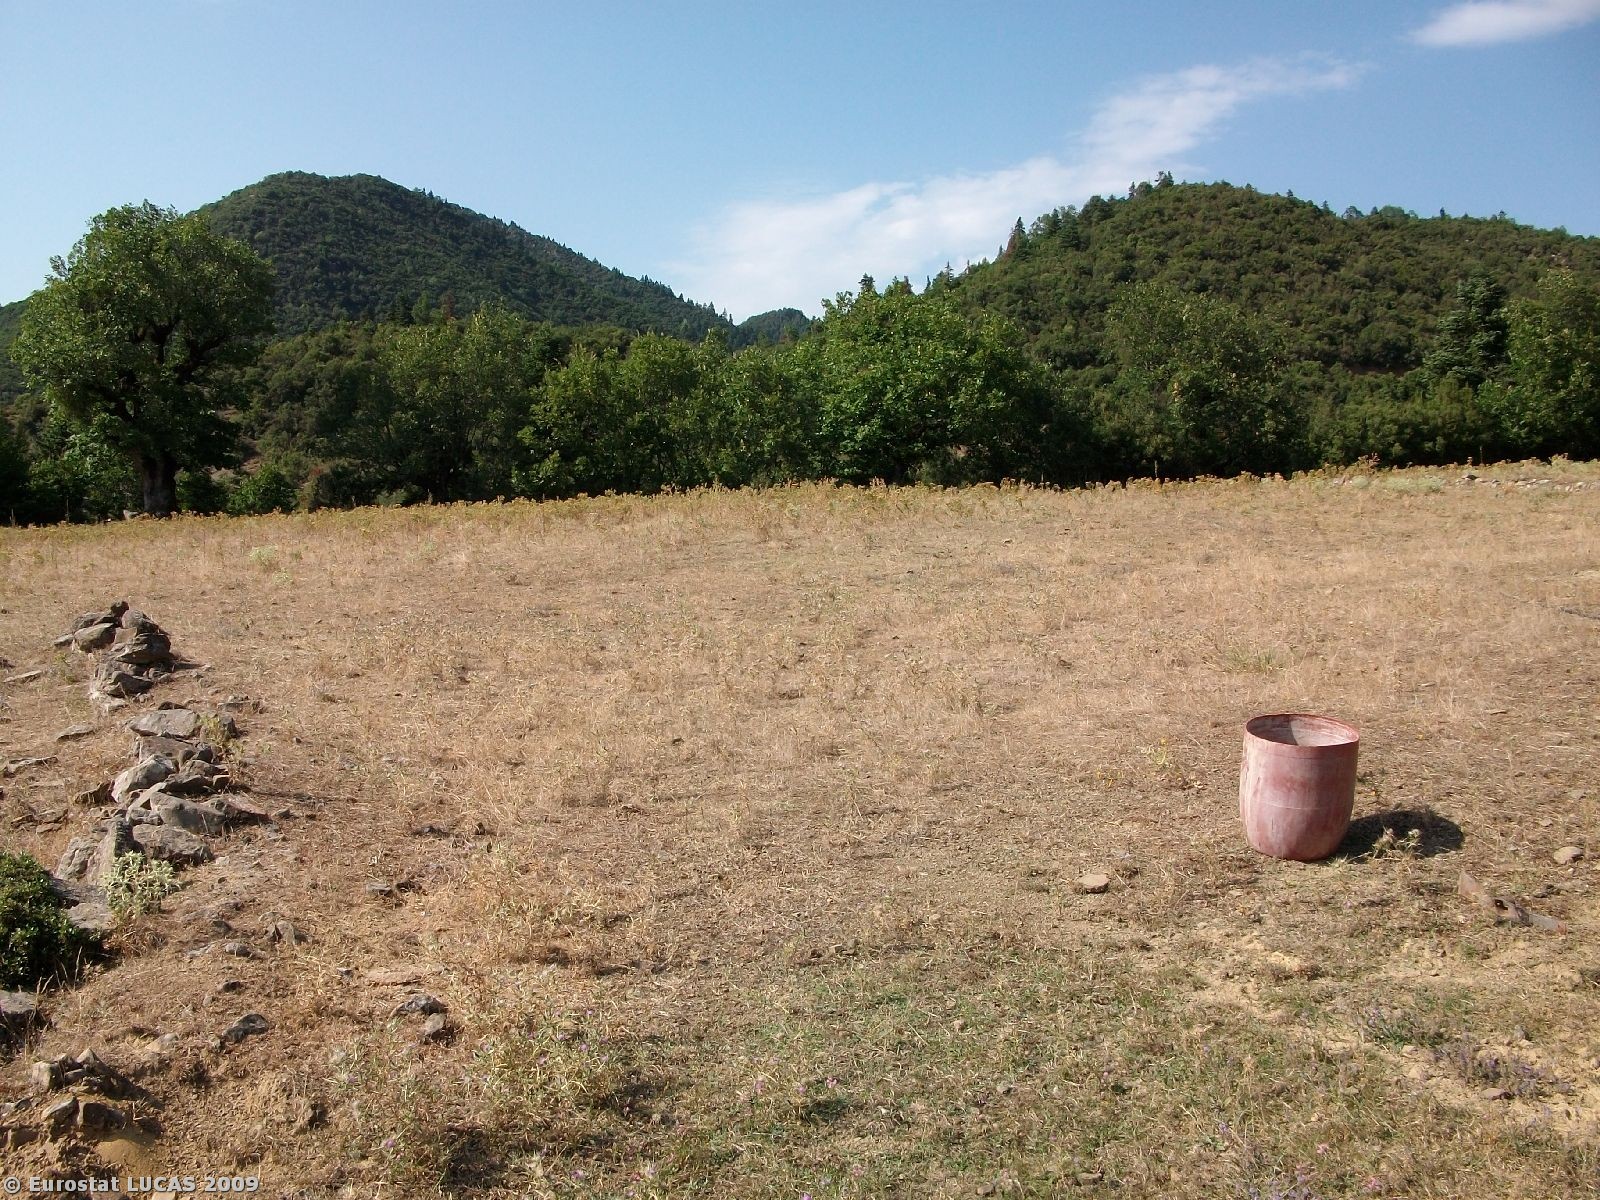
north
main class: Grassland
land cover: Grassland without tree/shrub cover
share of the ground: > 75 %
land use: Agriculture (excluding fallow land and kitchen gardens)
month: August
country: GR
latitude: 39.0566
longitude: 21.5201
